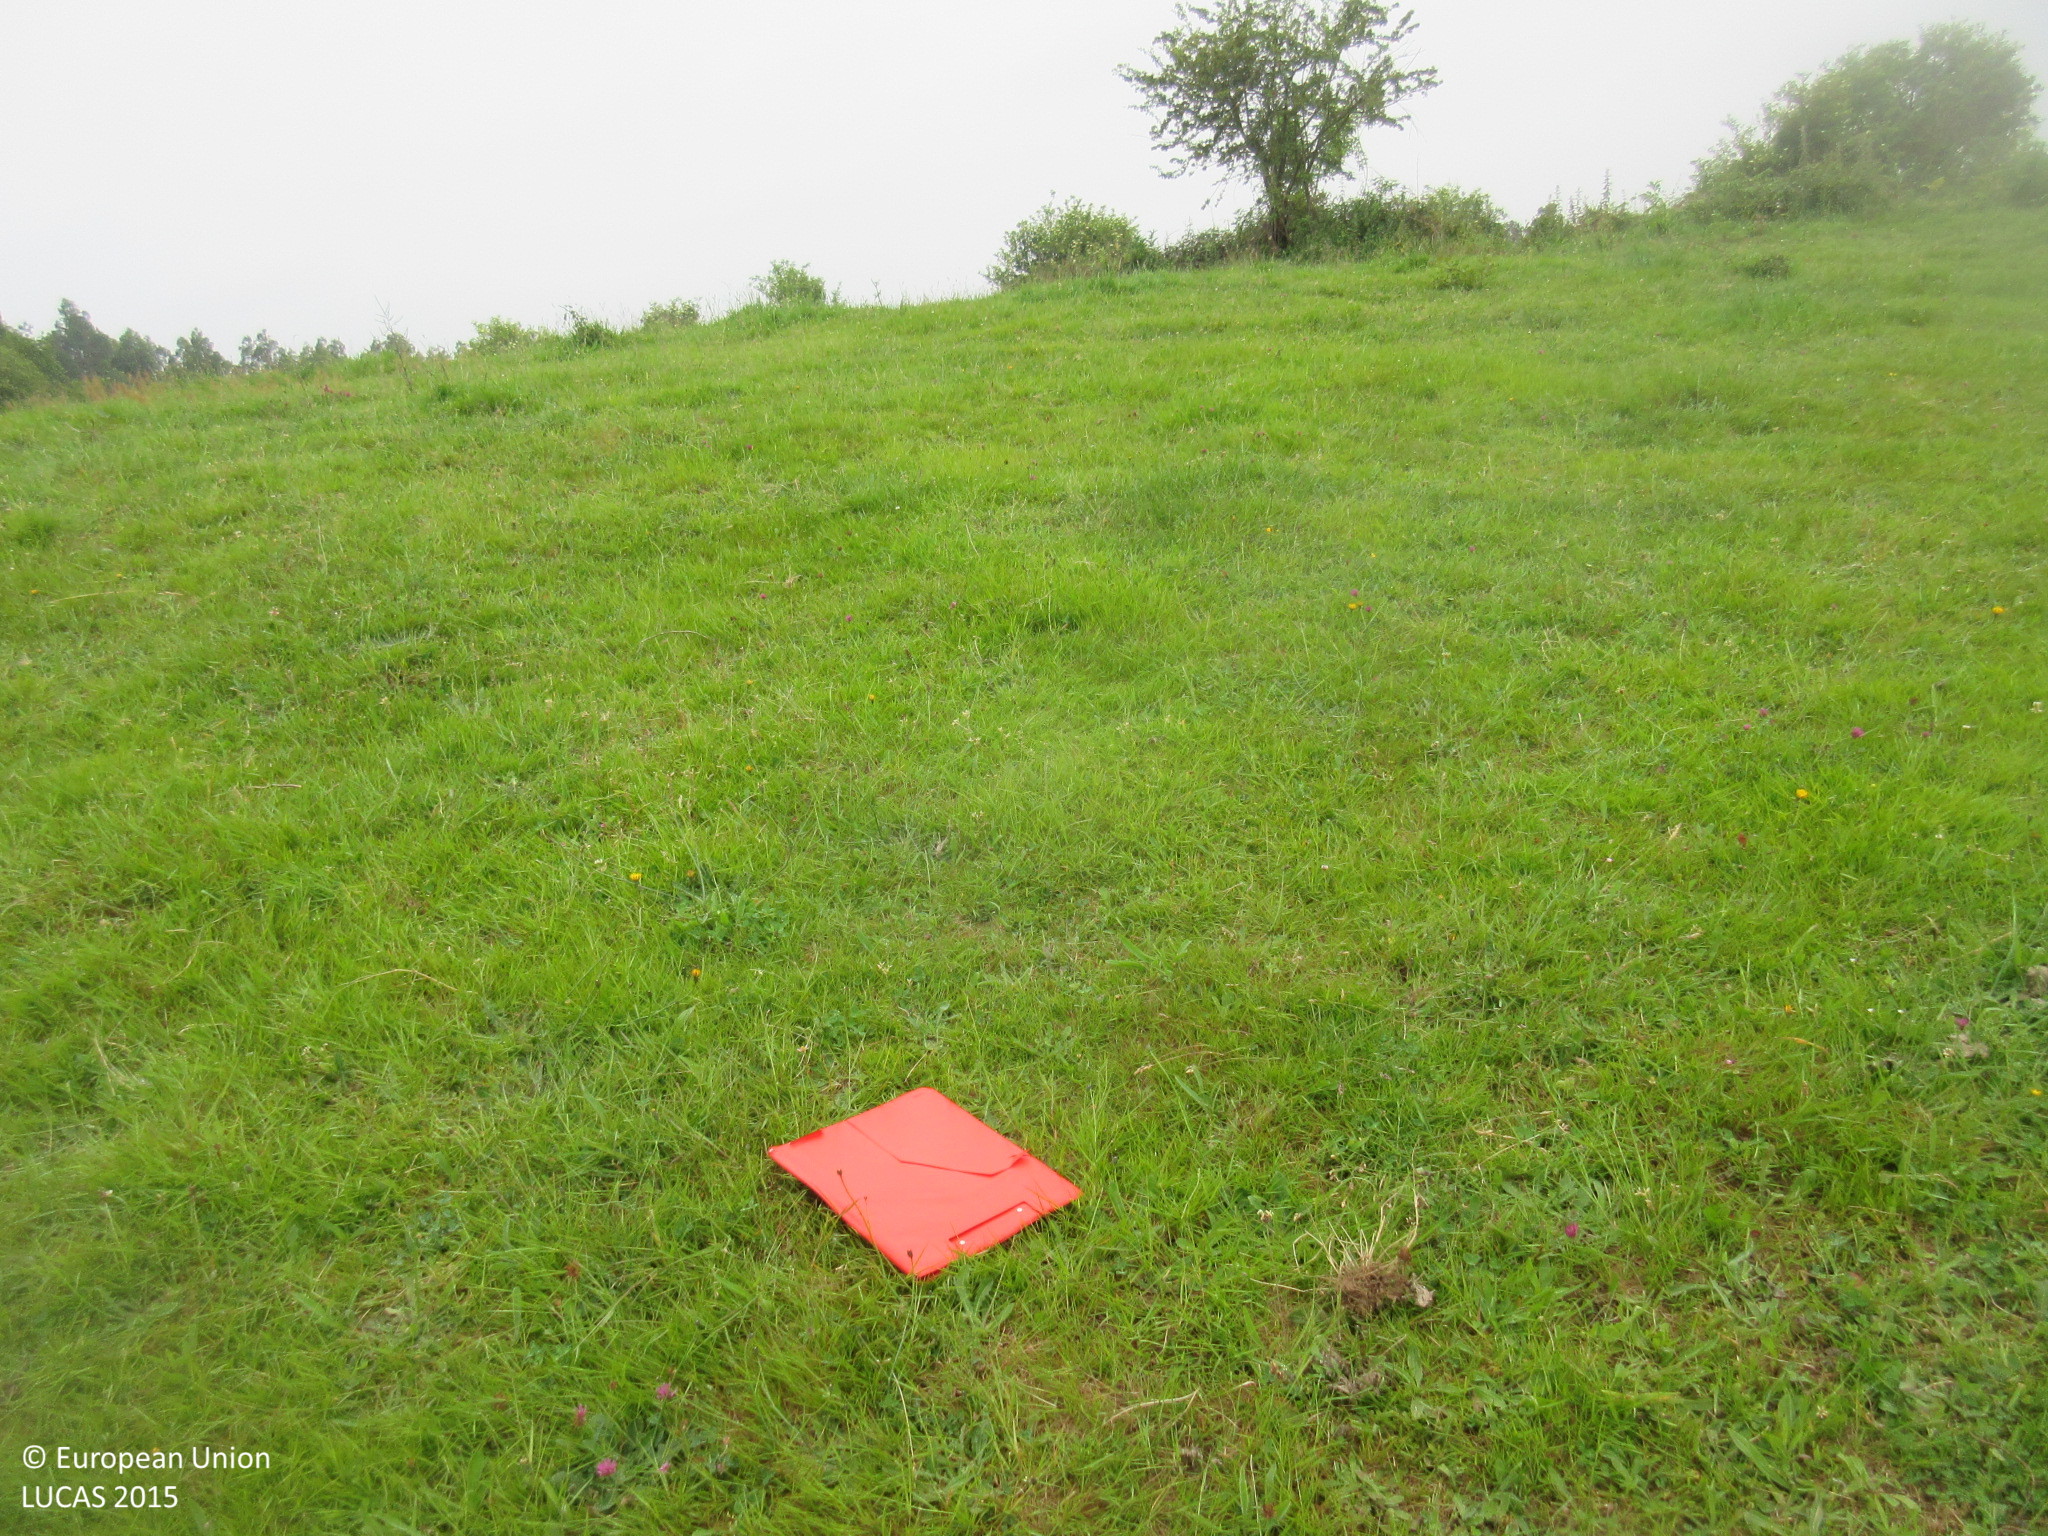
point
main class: Grassland
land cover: Grassland without tree/shrub cover
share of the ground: > 75 %
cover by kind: herbaceous plants 100 %
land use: Agriculture (excluding fallow land and kitchen gardens)
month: June
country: ES
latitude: 43.3737
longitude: -4.1610
